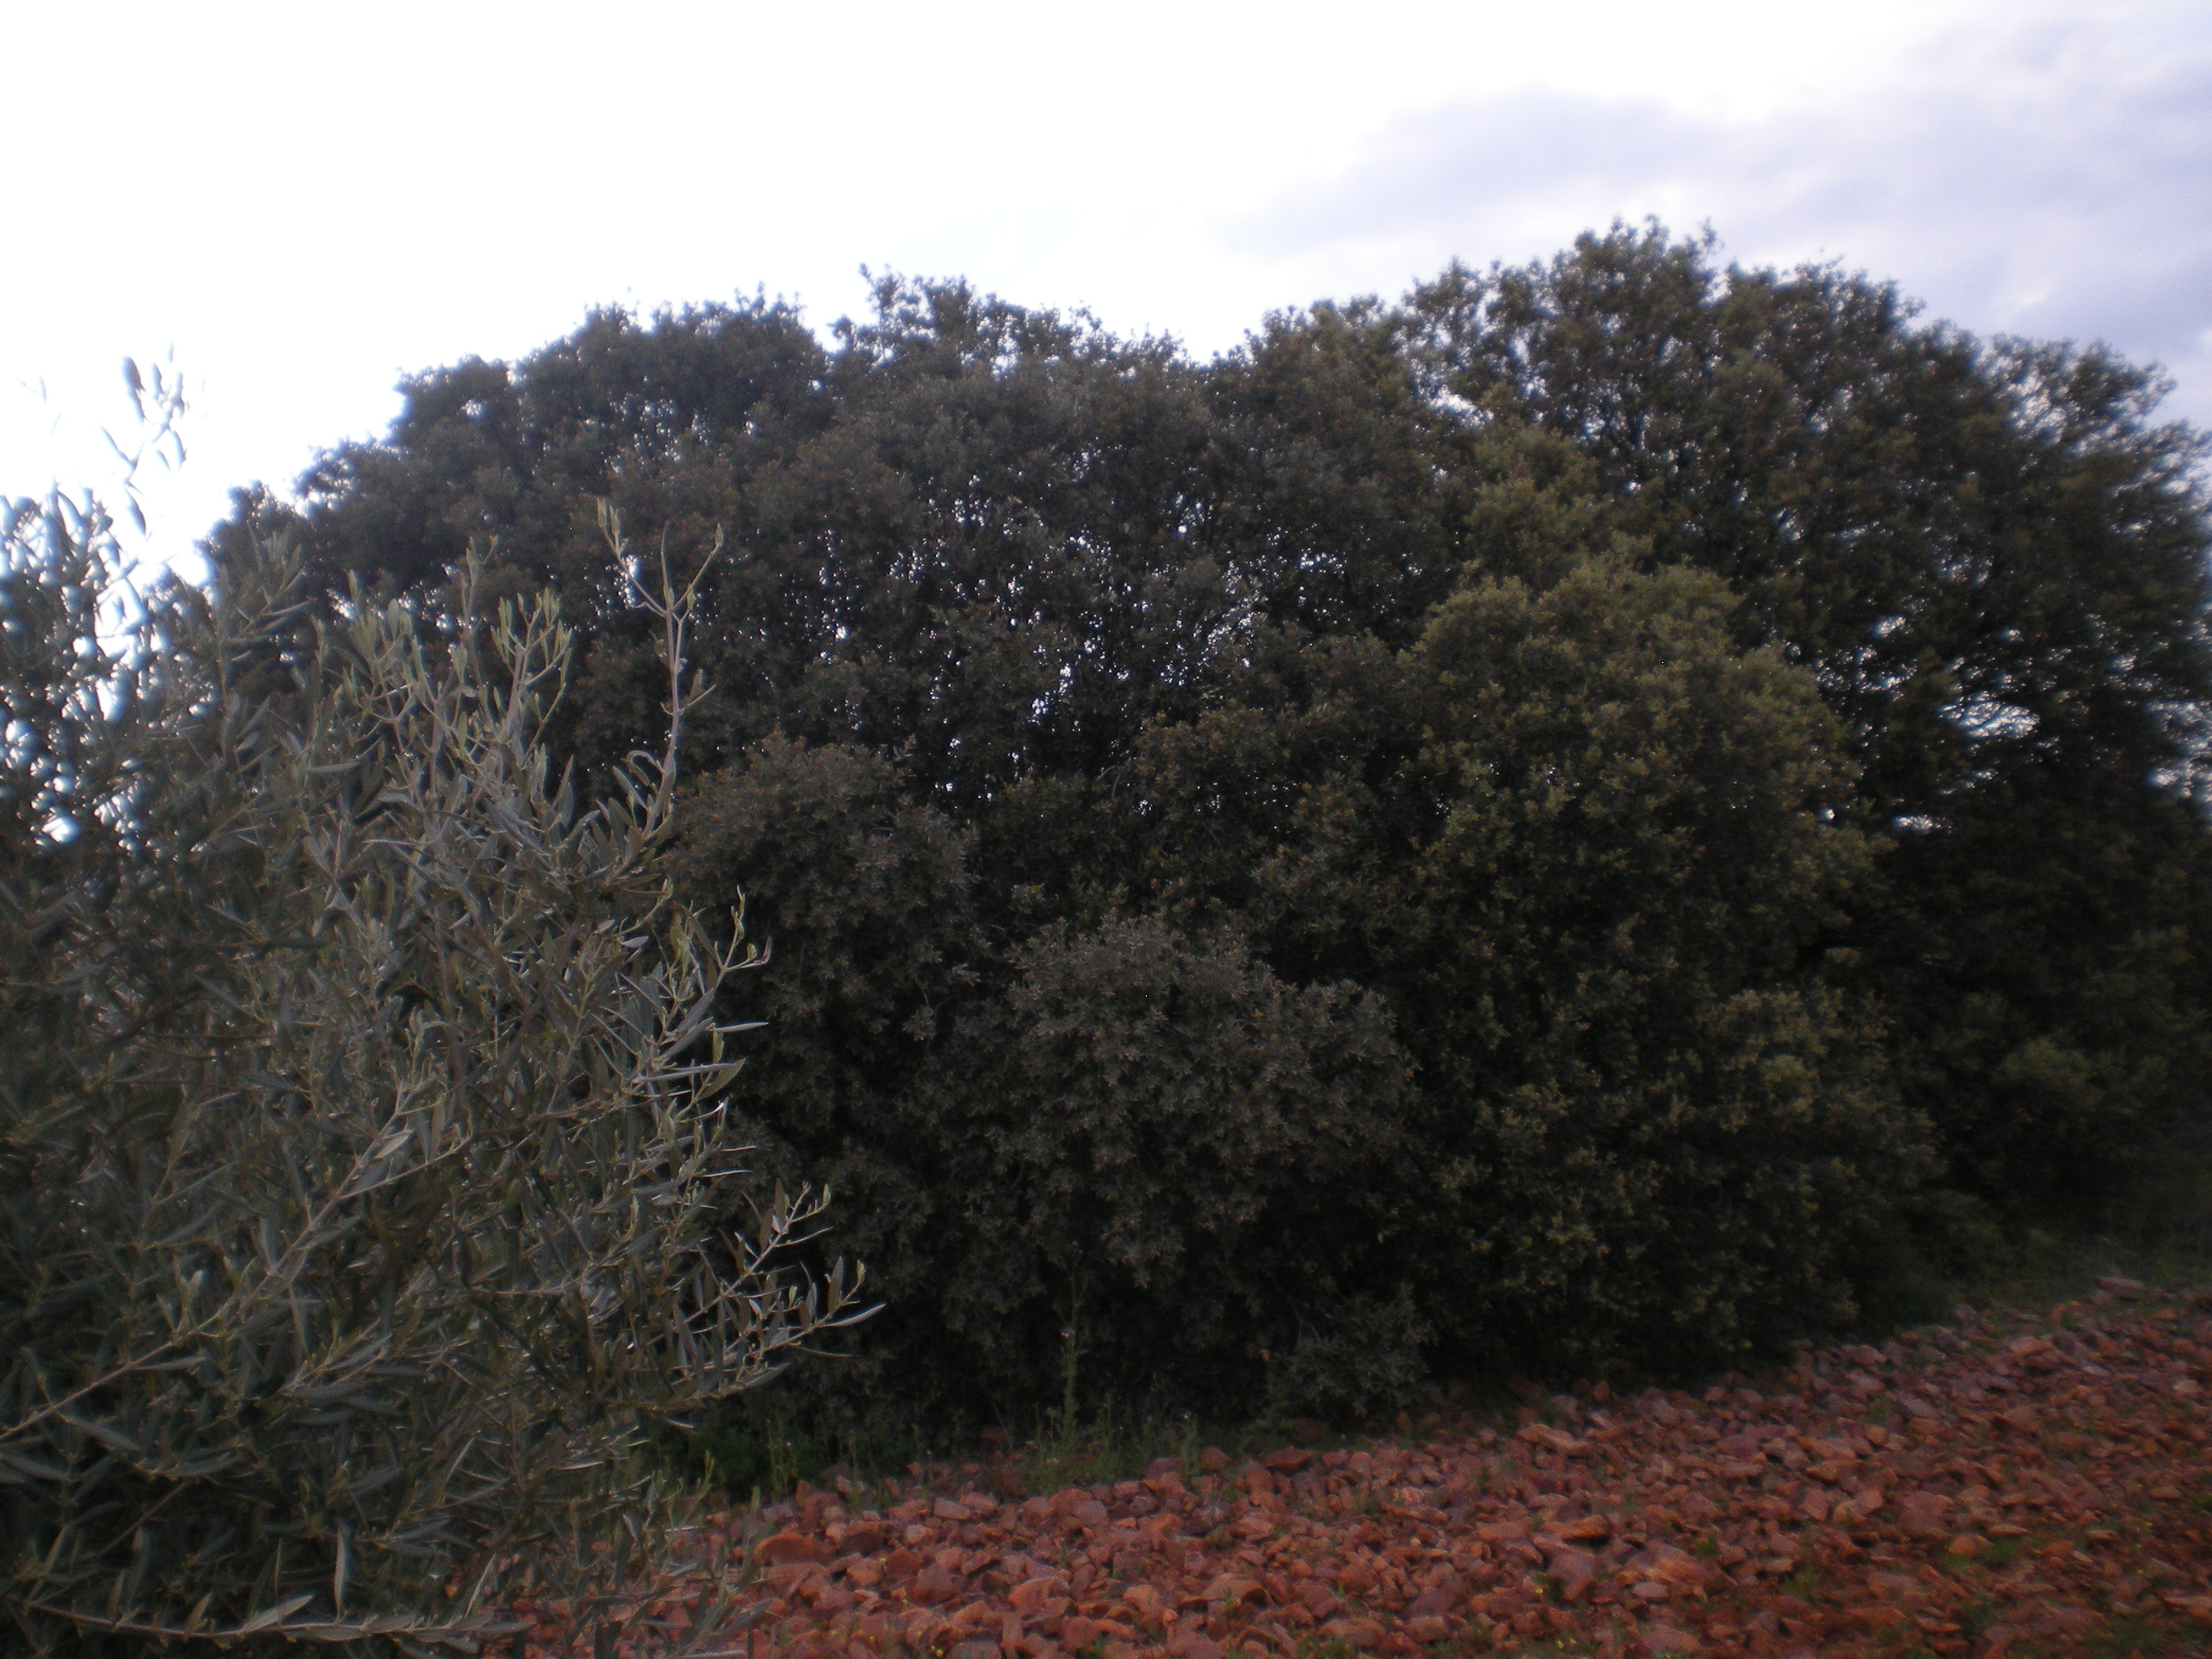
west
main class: Cropland
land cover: Olive groves
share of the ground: 10 - 25 %
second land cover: Spontaneously vegetated surfaces
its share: 25 - 50 %
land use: Agriculture (excluding fallow land and kitchen gardens)
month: April
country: ES
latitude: 38.8636
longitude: -3.5557
